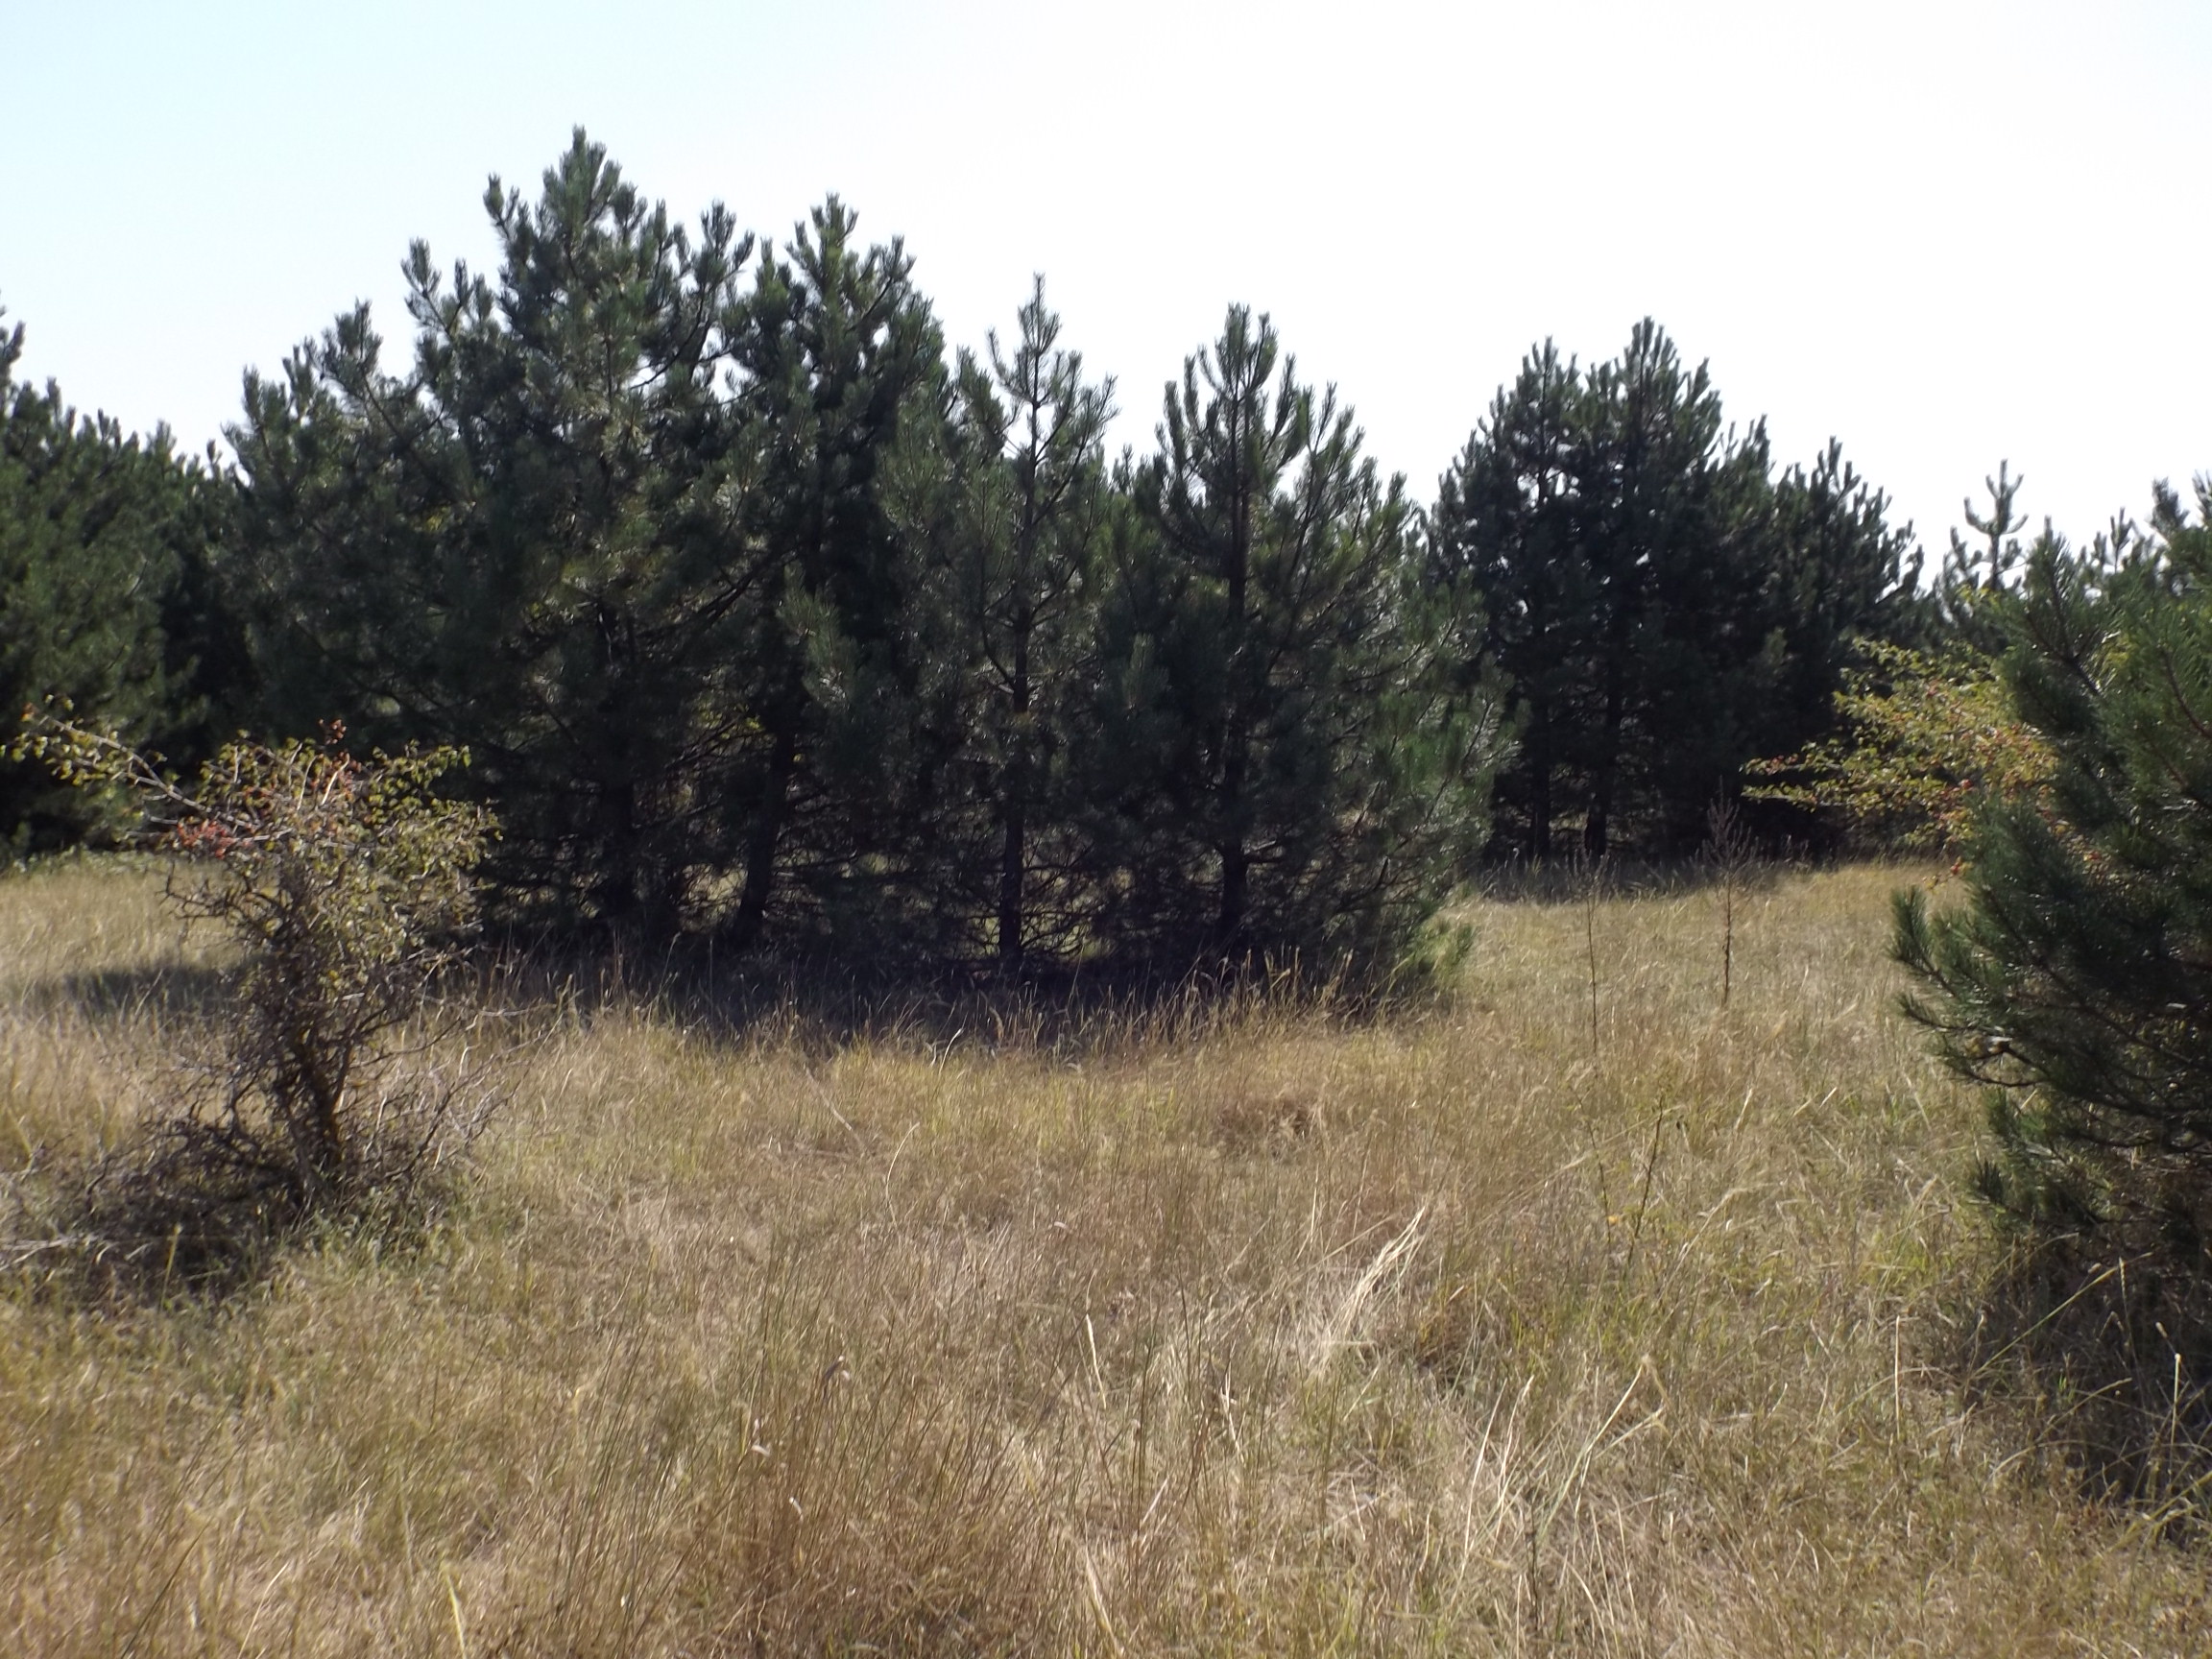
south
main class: Woodland
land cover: Pine dominated coniferous woodland
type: alpine coniferous forest
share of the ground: 50 - 75 %
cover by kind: coniferous forest trees 55 %, herbaceous plants 40 %, shrubs 5 %
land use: Forestry
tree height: < 5 m
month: August
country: BG
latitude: 43.0906
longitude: 27.3827
